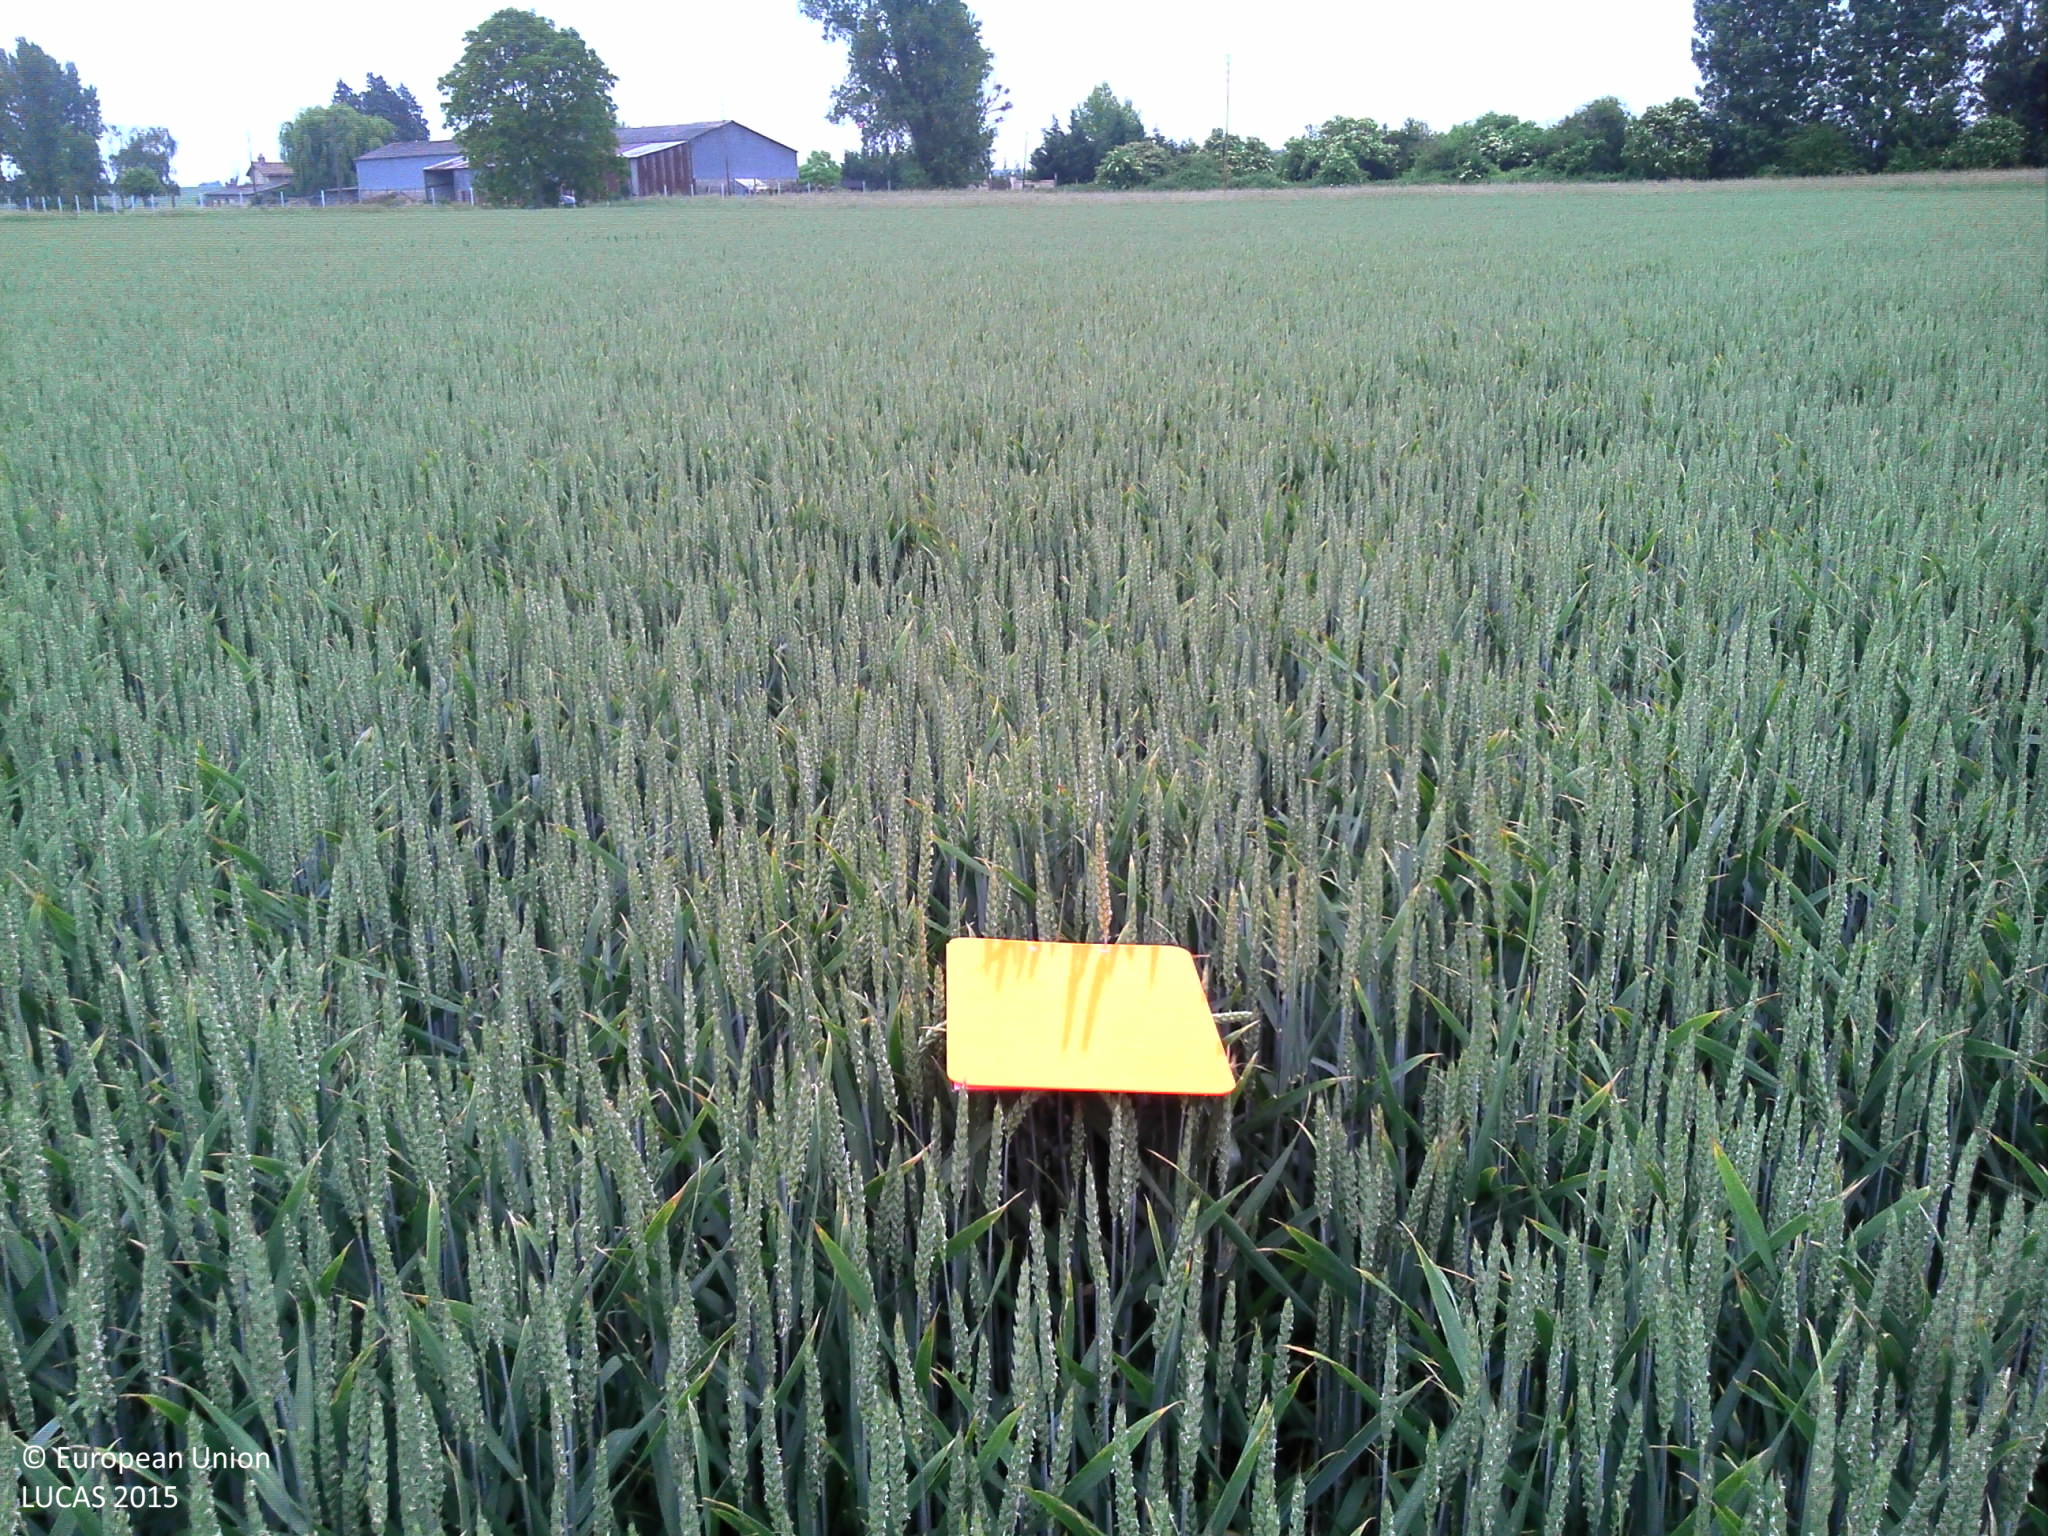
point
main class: Cropland
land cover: Common wheat
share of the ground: > 75 %
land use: Agriculture (excluding fallow land and kitchen gardens)
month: May
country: FR
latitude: 47.0686
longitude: 0.0875
